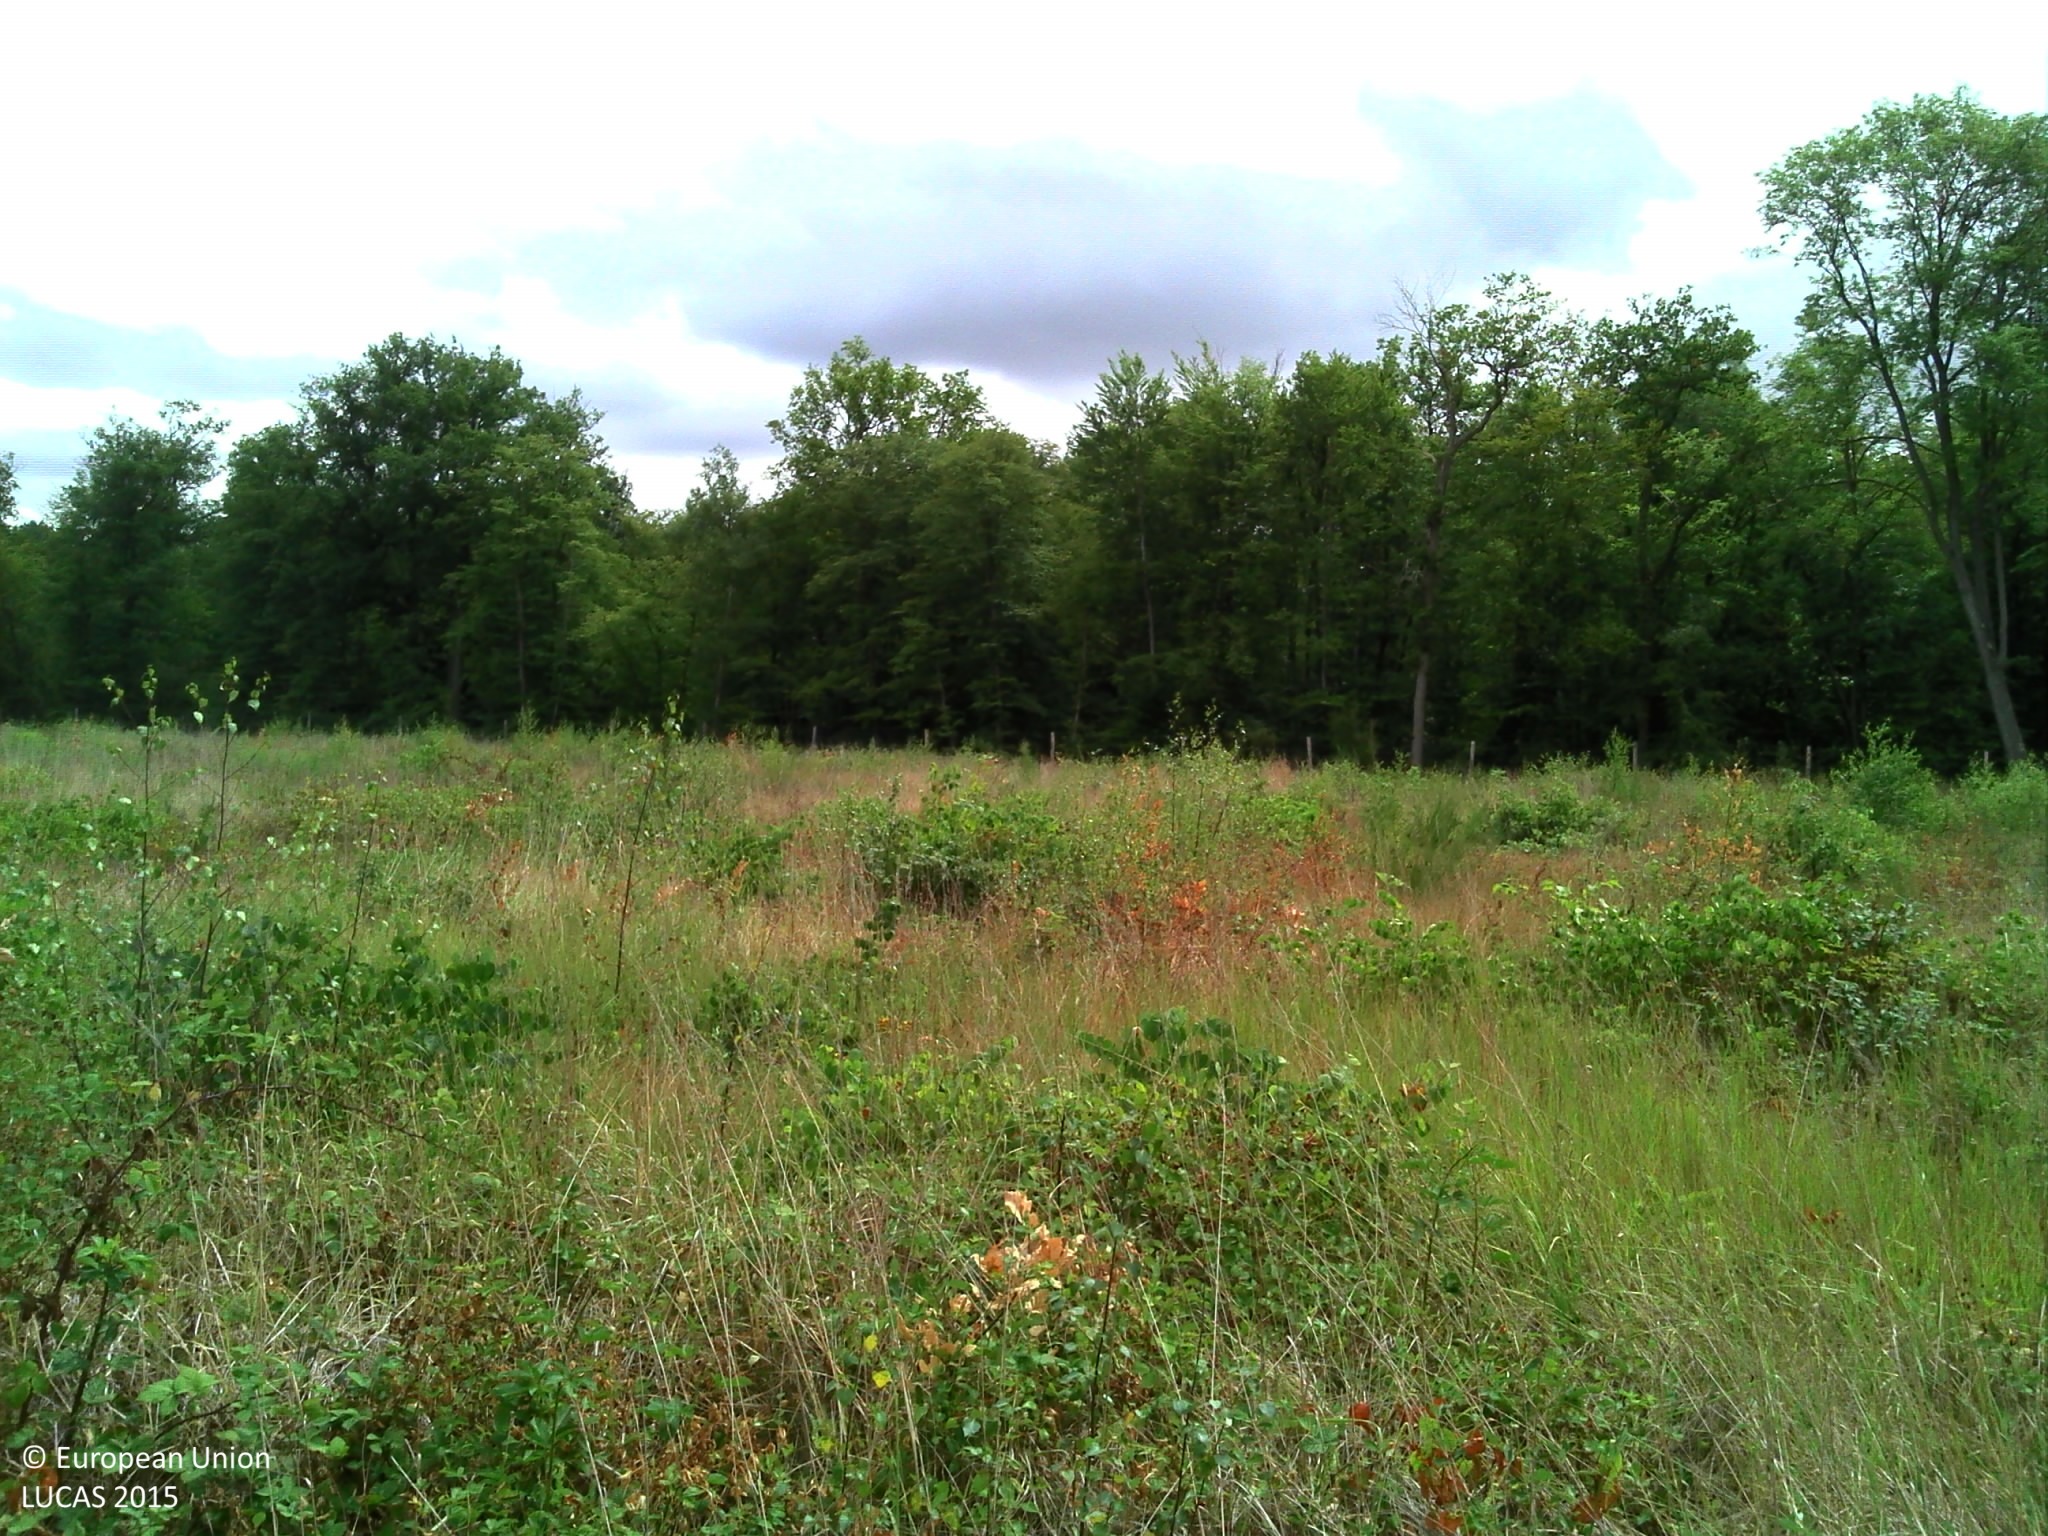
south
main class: Shrubland
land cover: Shrubland with sparse tree cover
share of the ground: > 75 %
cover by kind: shrubs 55 %, herbaceous plants 40 %, broadleaved forest trees 5 %
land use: Semi-natural and natural areas not in use
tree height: < 5 m
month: July
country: FR
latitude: 49.1416
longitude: 2.4901
